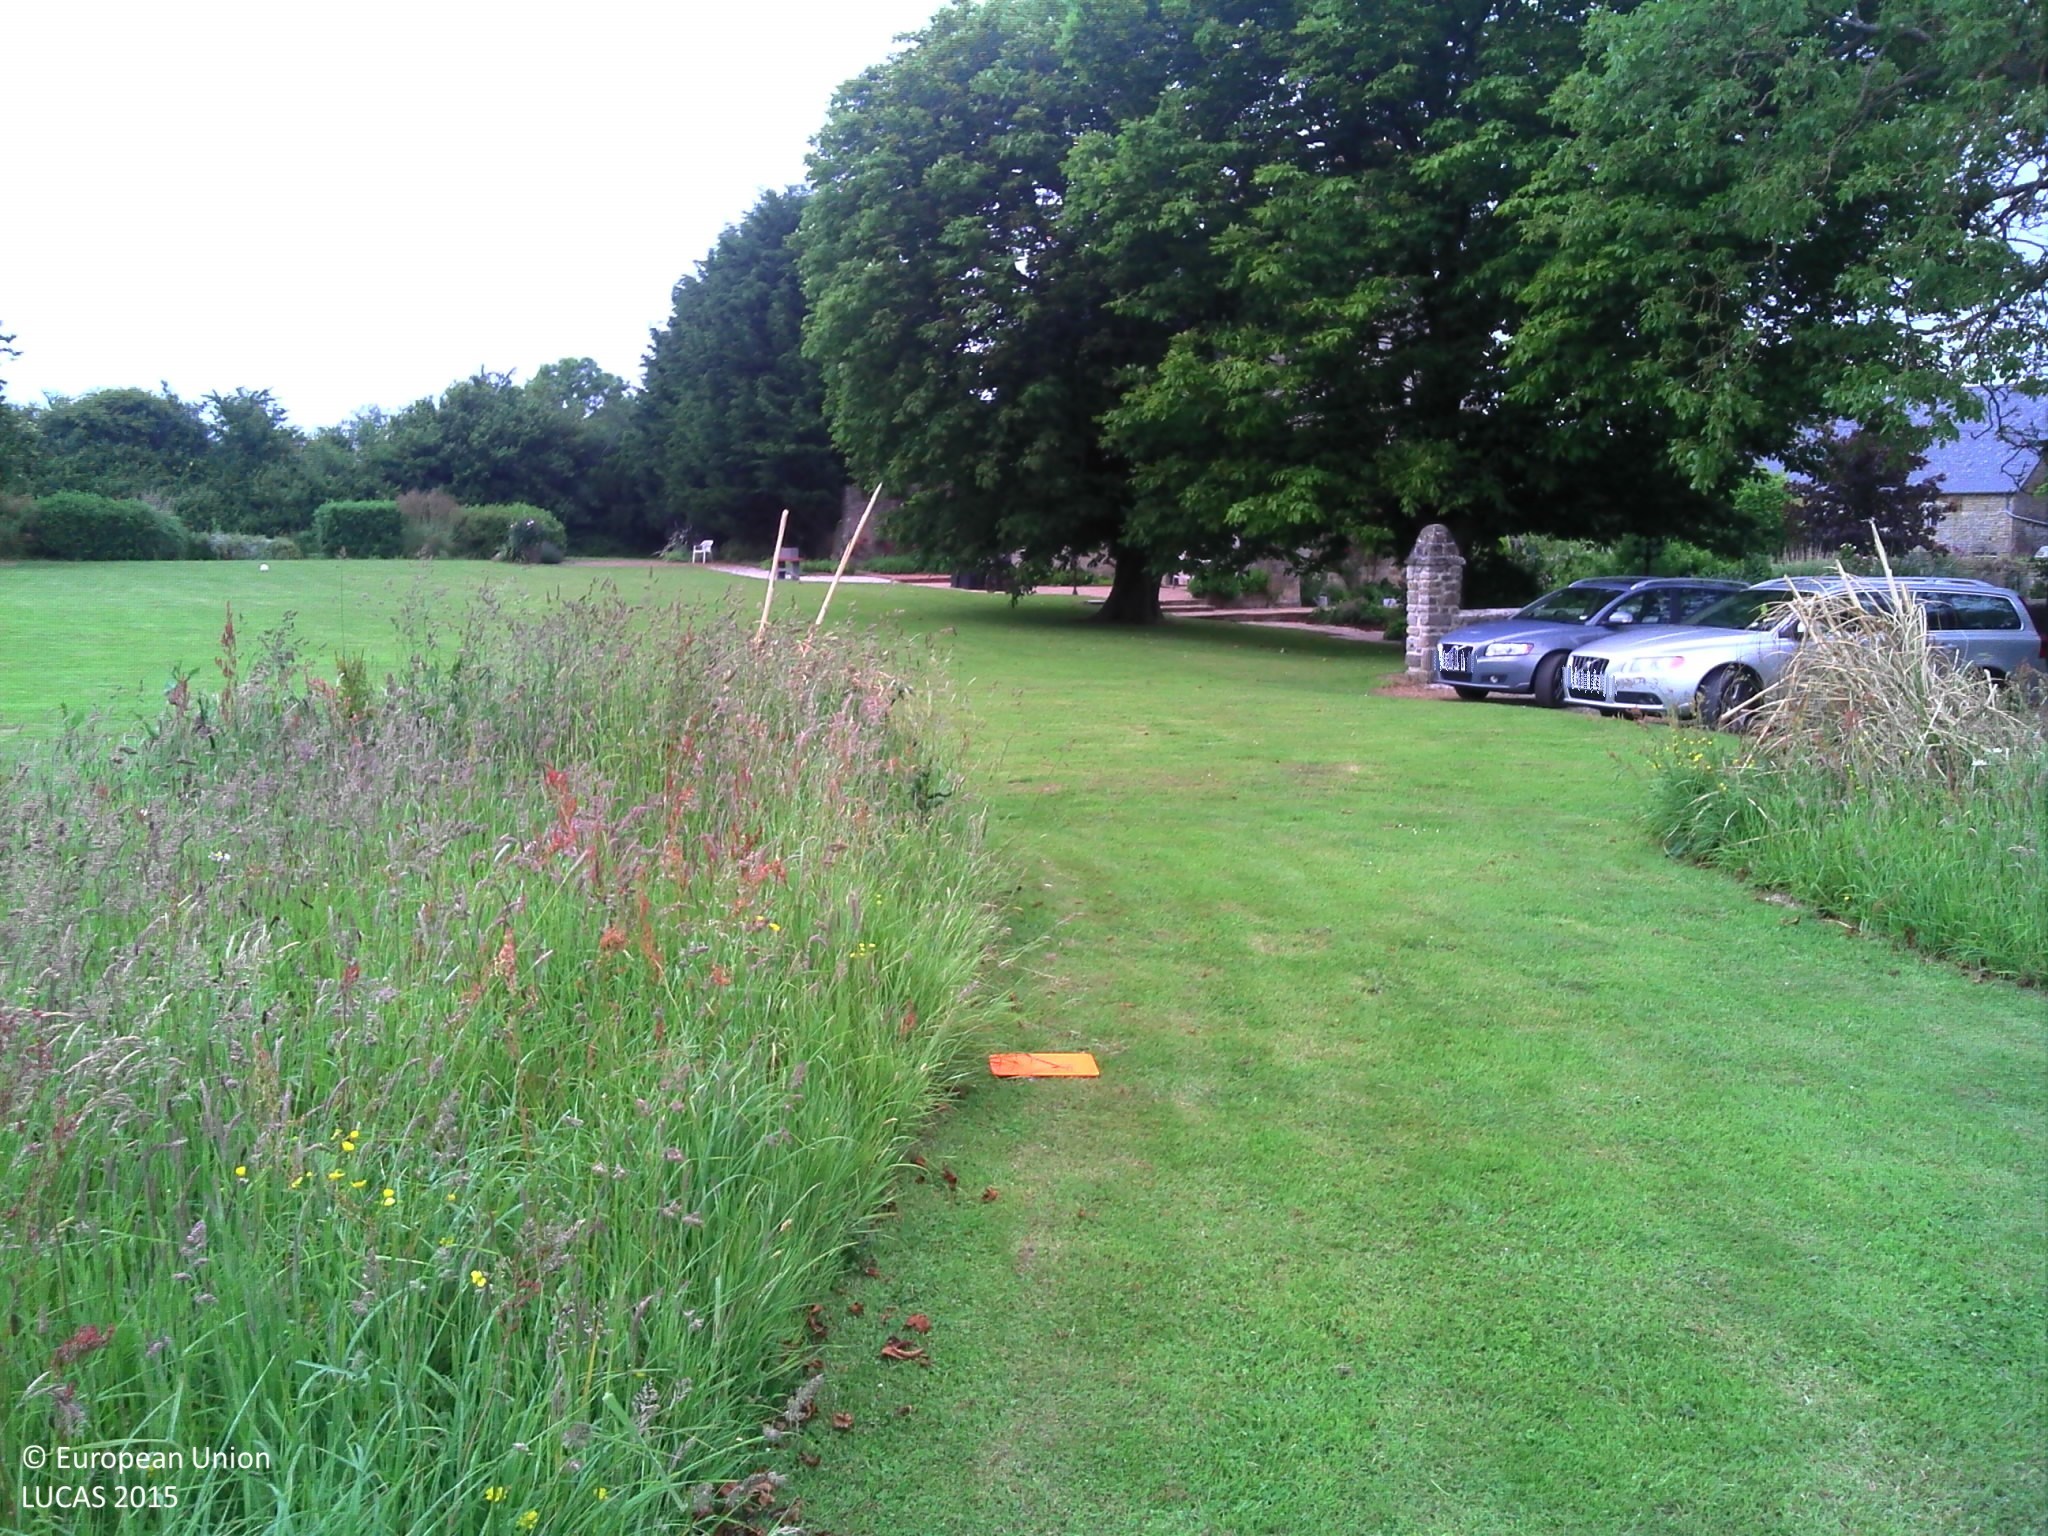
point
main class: Grassland
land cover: Grassland without tree/shrub cover
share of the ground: > 75 %
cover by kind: herbaceous plants 100 %
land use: Residential
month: June
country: FR
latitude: 49.3759
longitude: -1.3829
